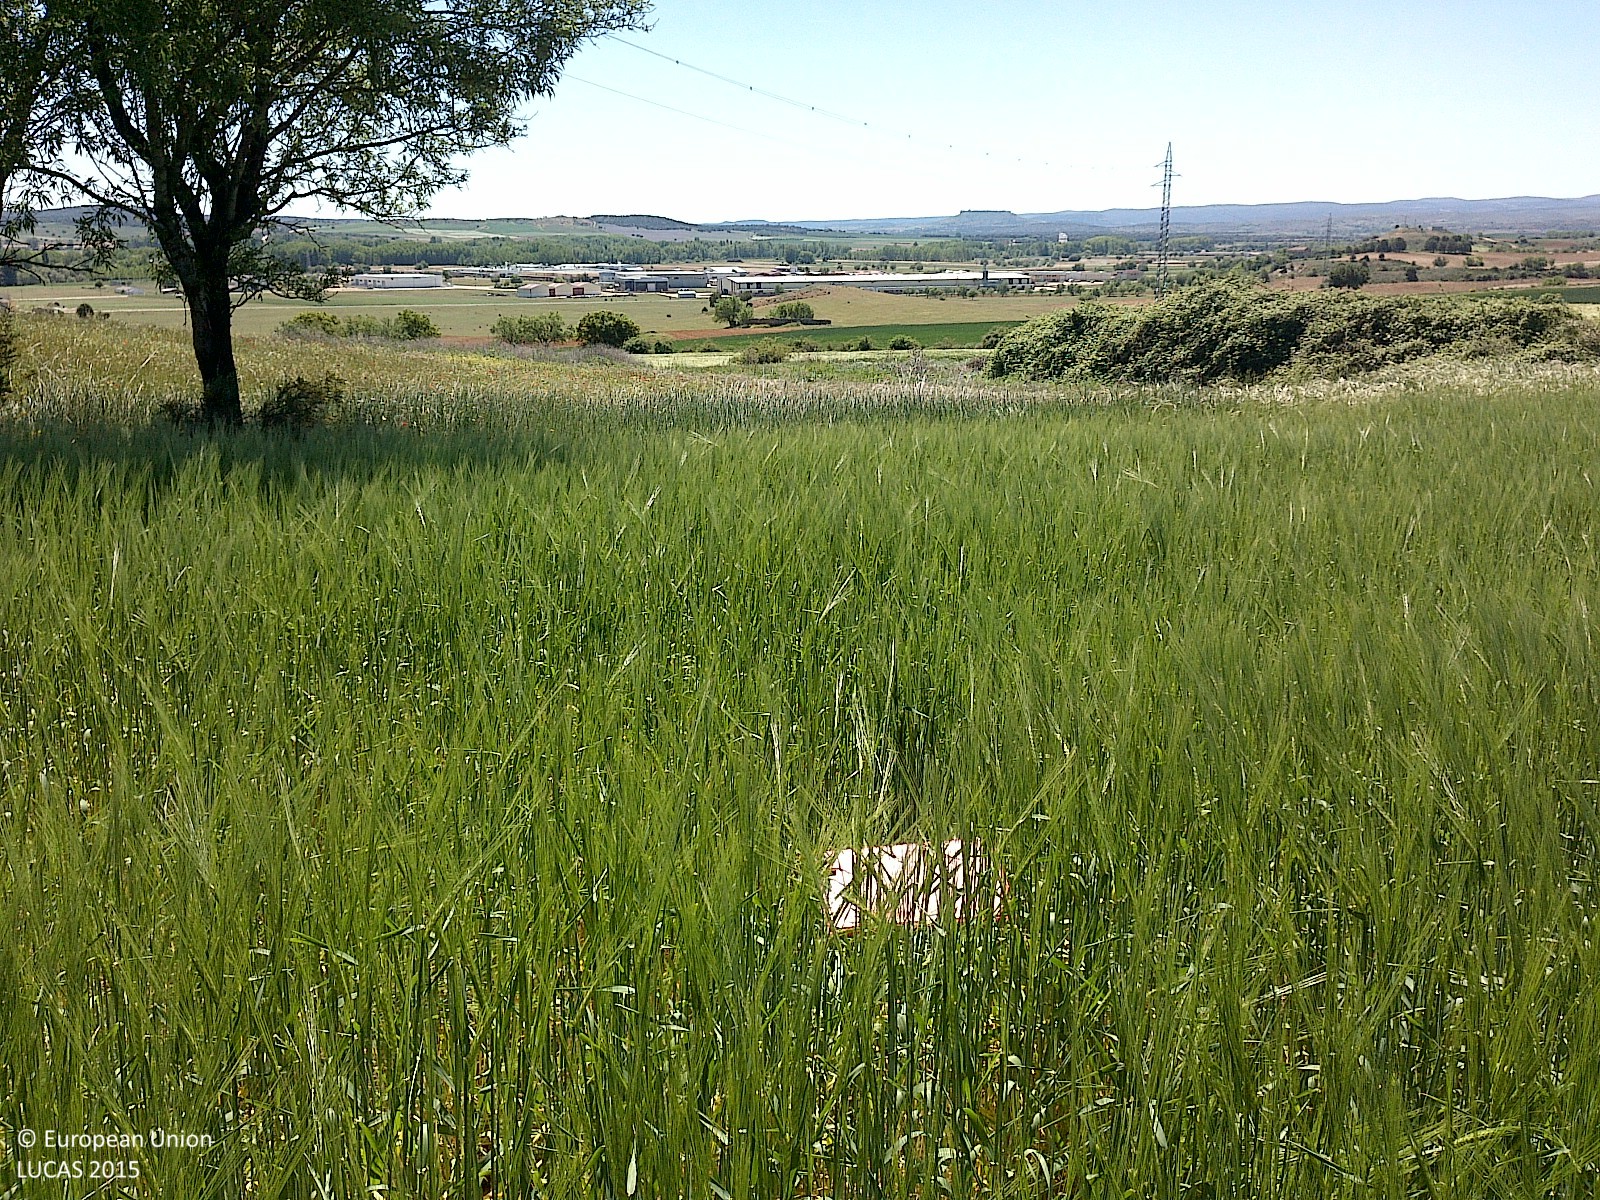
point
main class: Cropland
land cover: Barley
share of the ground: > 75 %
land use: Agriculture (excluding fallow land and kitchen gardens)
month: May
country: ES
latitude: 41.5614
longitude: -3.1015
